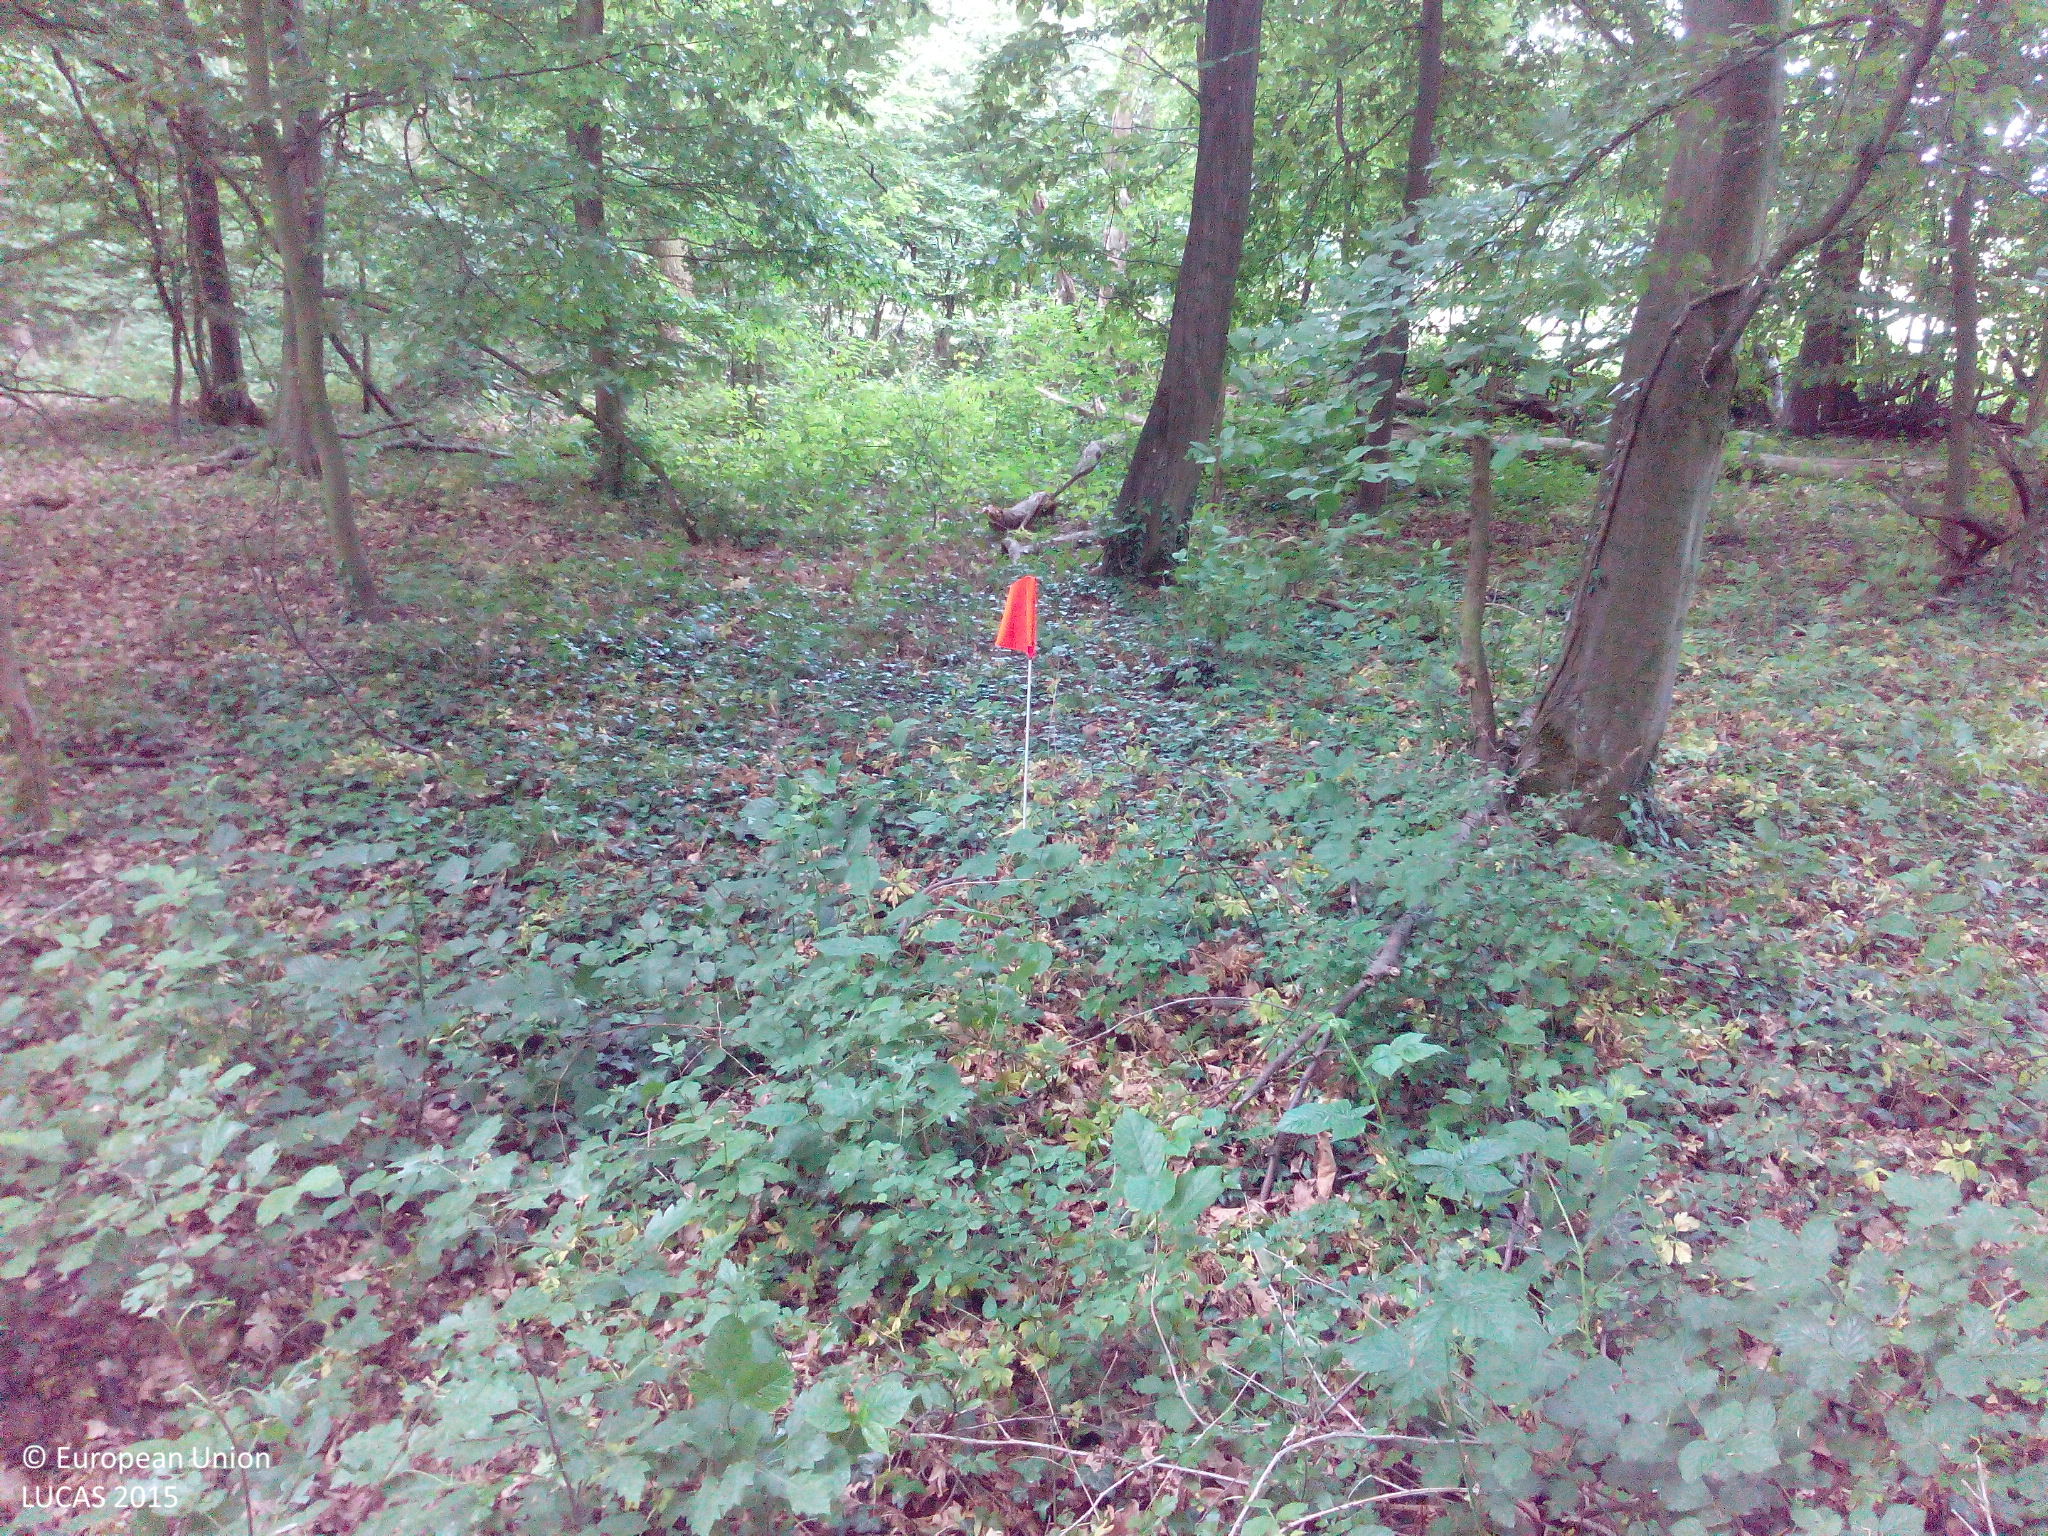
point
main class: Woodland
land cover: Broadleaved woodland
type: mesophytic deciduous forest
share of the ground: > 75 %
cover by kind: broadleaved forest trees 80 %, herbaceous plants 10 %, shrubs 5 %, unconsolidated bare surface 5 %
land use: Forestry
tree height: > 5 m
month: May
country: DE
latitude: 49.9515
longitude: 8.0353
